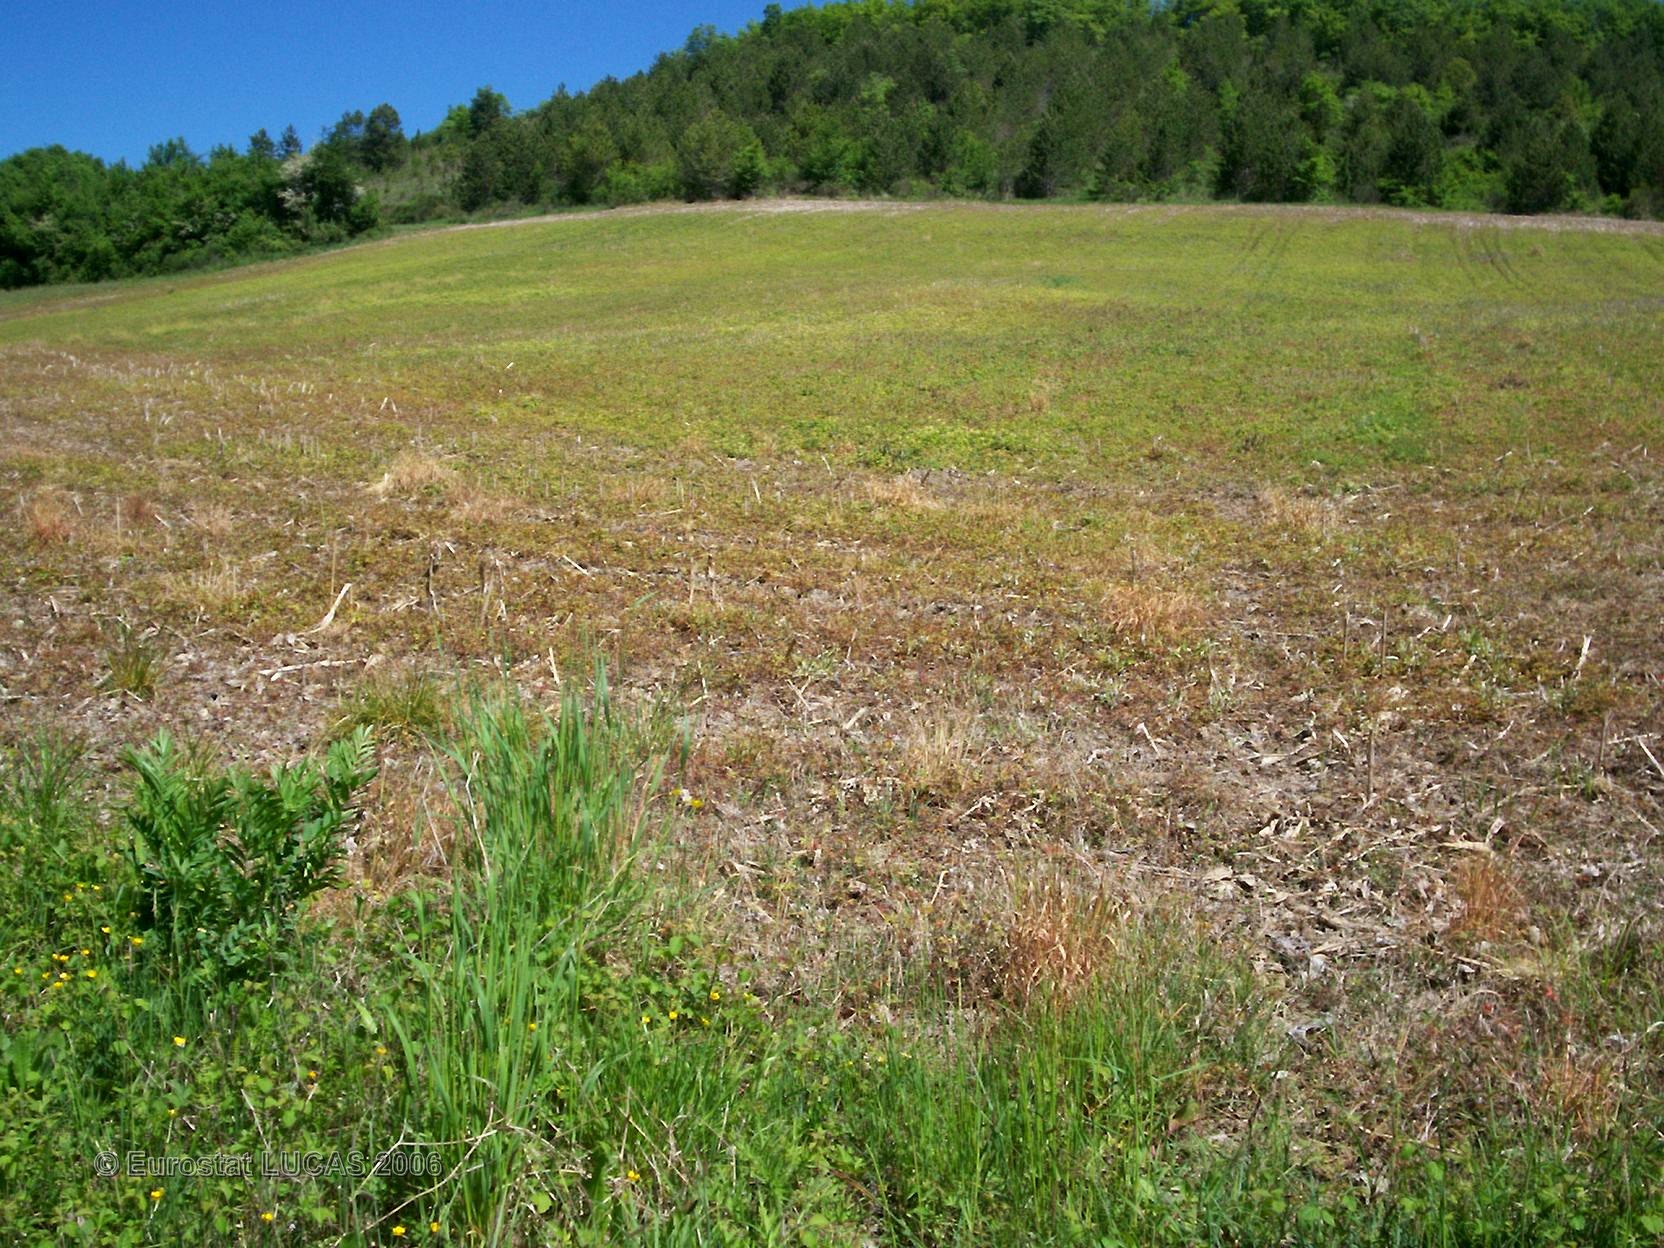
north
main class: Grassland
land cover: Grassland without tree/shrub cover
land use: Agriculture (excluding fallow land and kitchen gardens)
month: May
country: FR
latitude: 43.1529
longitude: 0.9149
